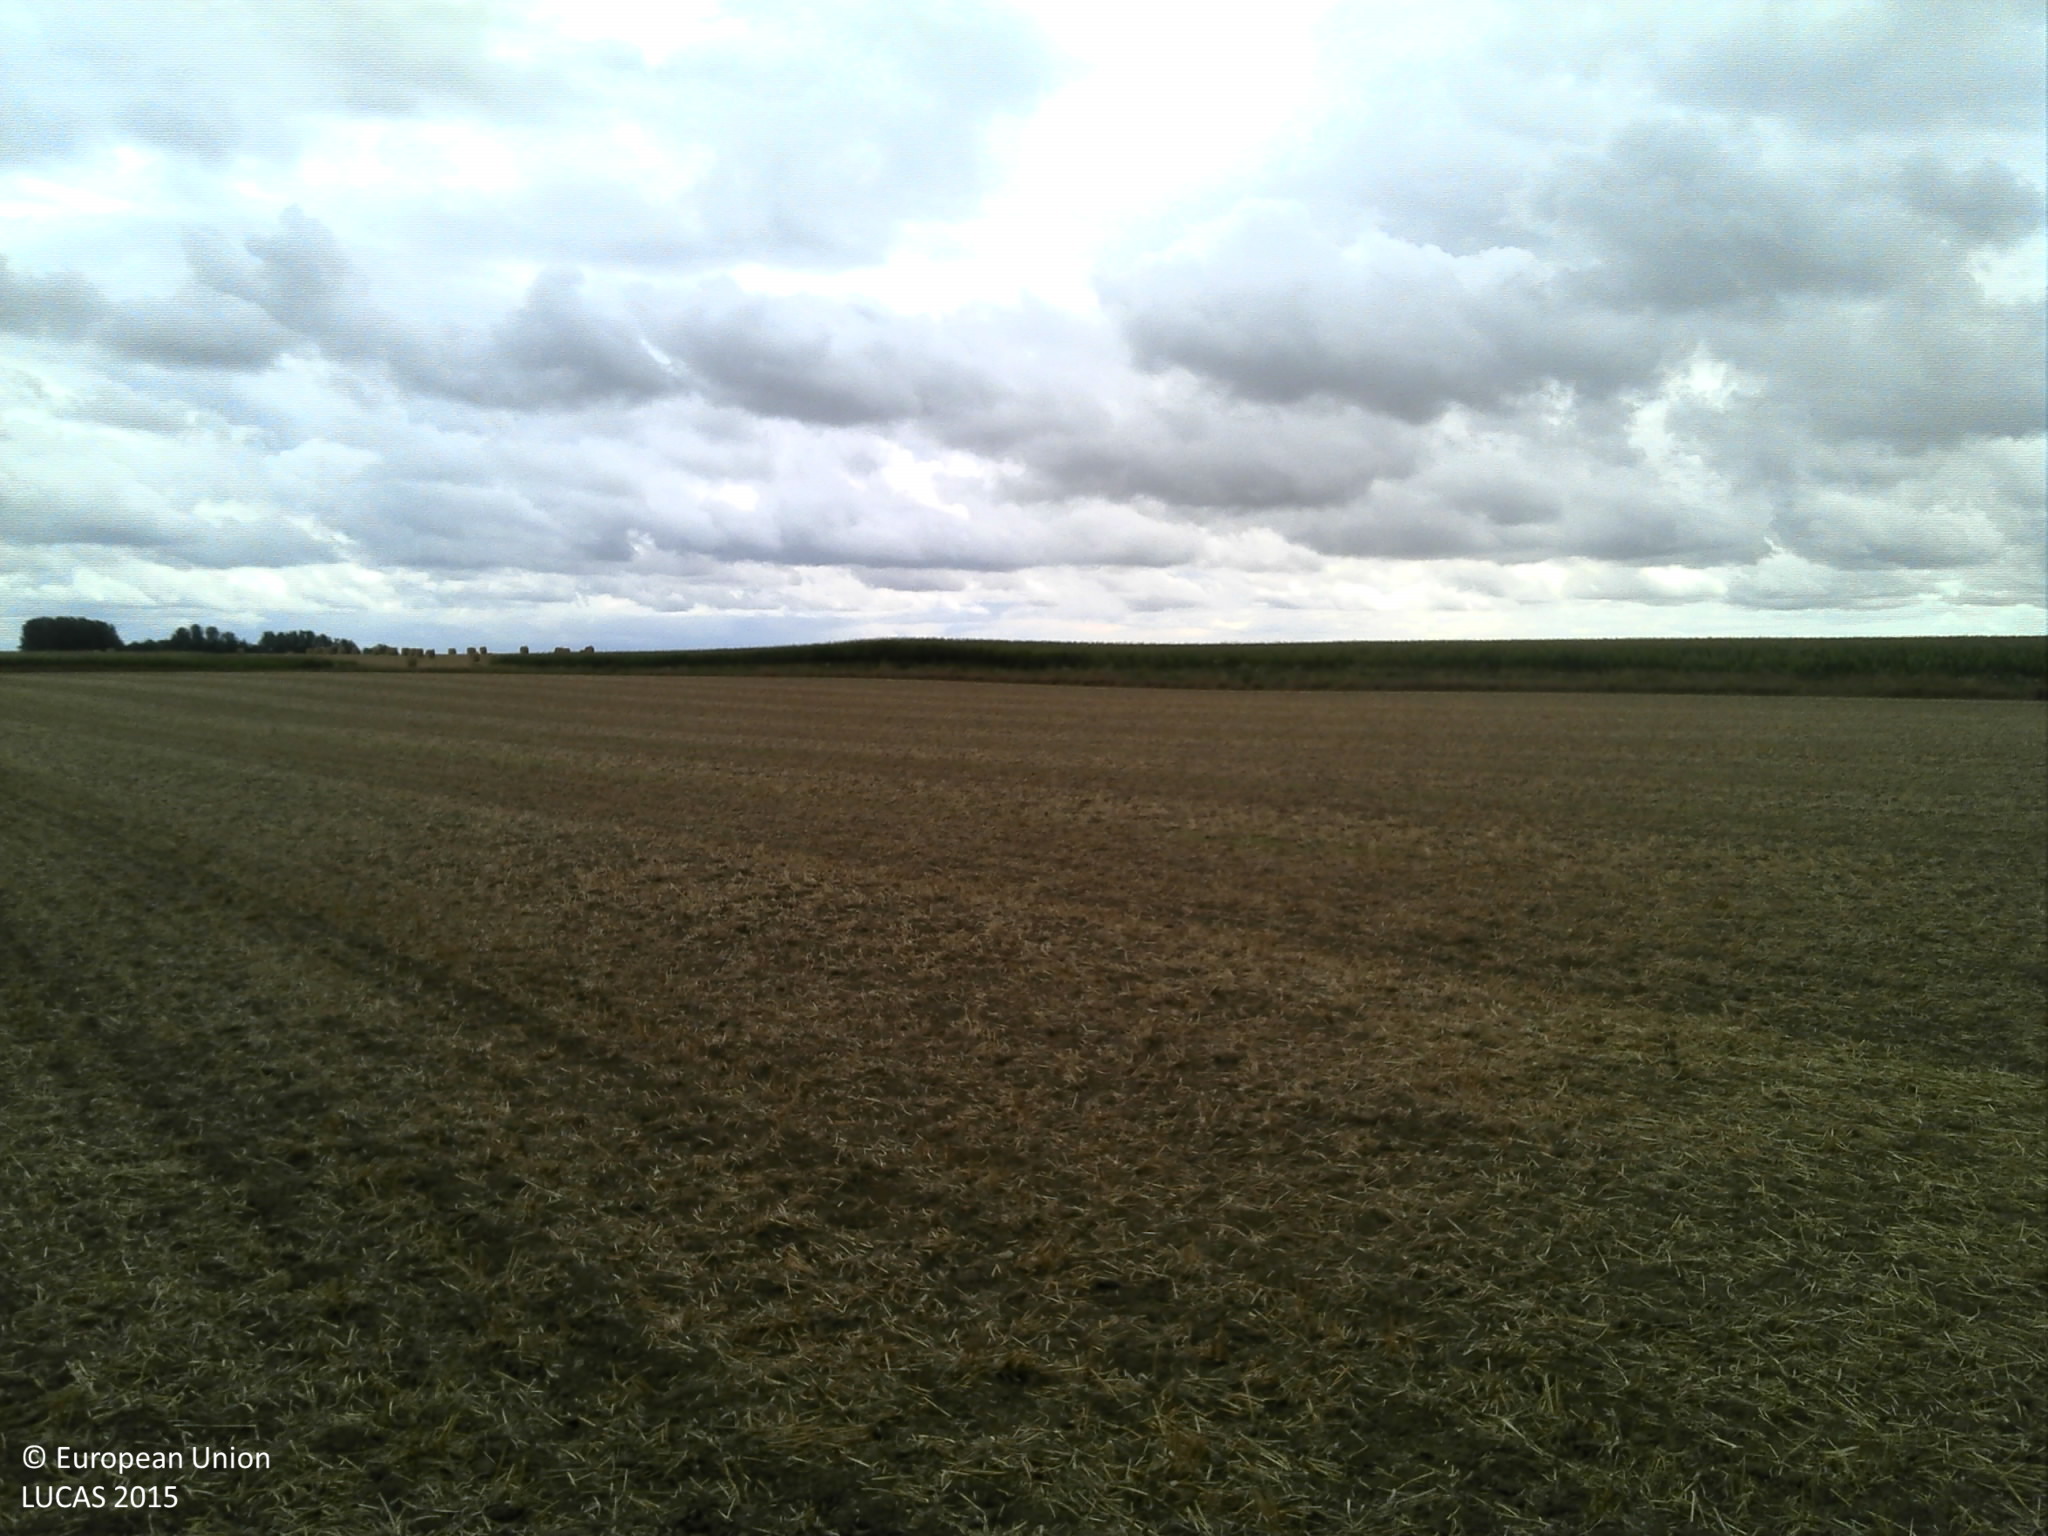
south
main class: Cropland
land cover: Barley
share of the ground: 25 - 50 %
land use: Agriculture (excluding fallow land and kitchen gardens)
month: July
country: FR
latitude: 49.4616
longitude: 4.6019
